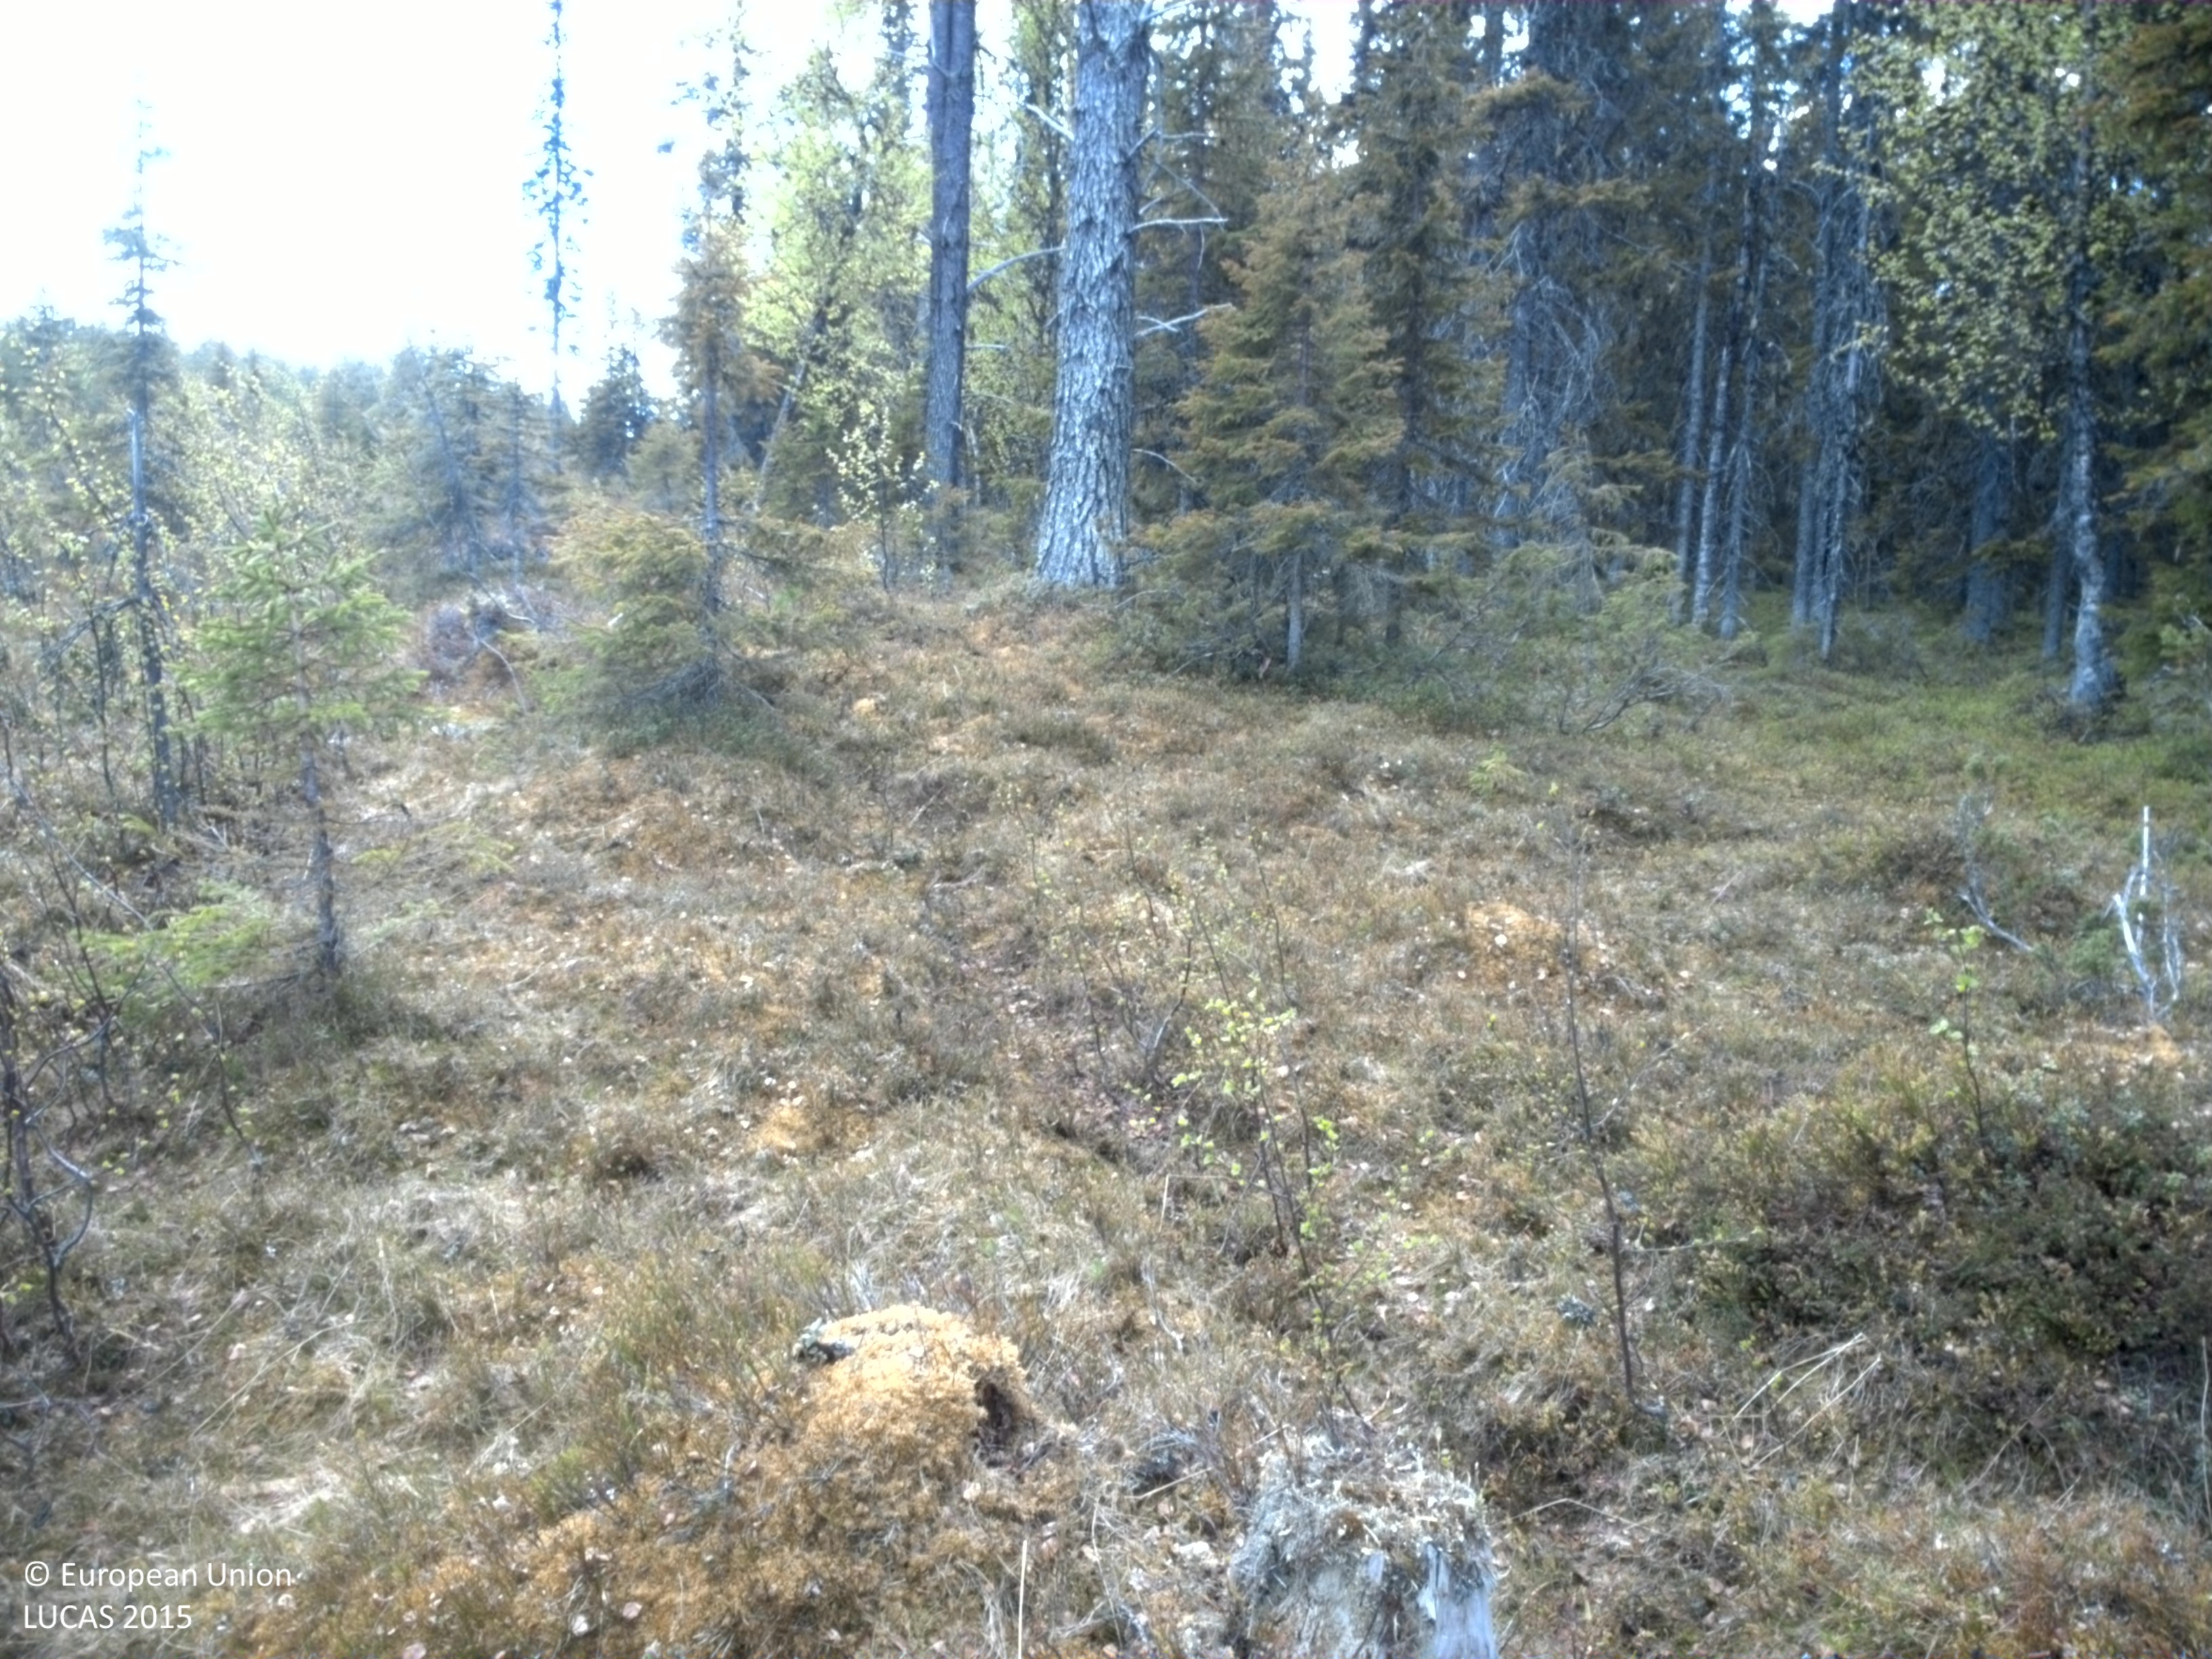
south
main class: Woodland
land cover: Spruce dominated mixed woodland
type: boreal forest
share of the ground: 10 - 25 %
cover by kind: shrubs 65 %, broadleaved forest trees 15 %, coniferous forest trees 10 %, herbaceous plants 10 %
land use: Forestry
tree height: < 5 m
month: June
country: SE
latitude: 65.8427
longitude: 18.8703
